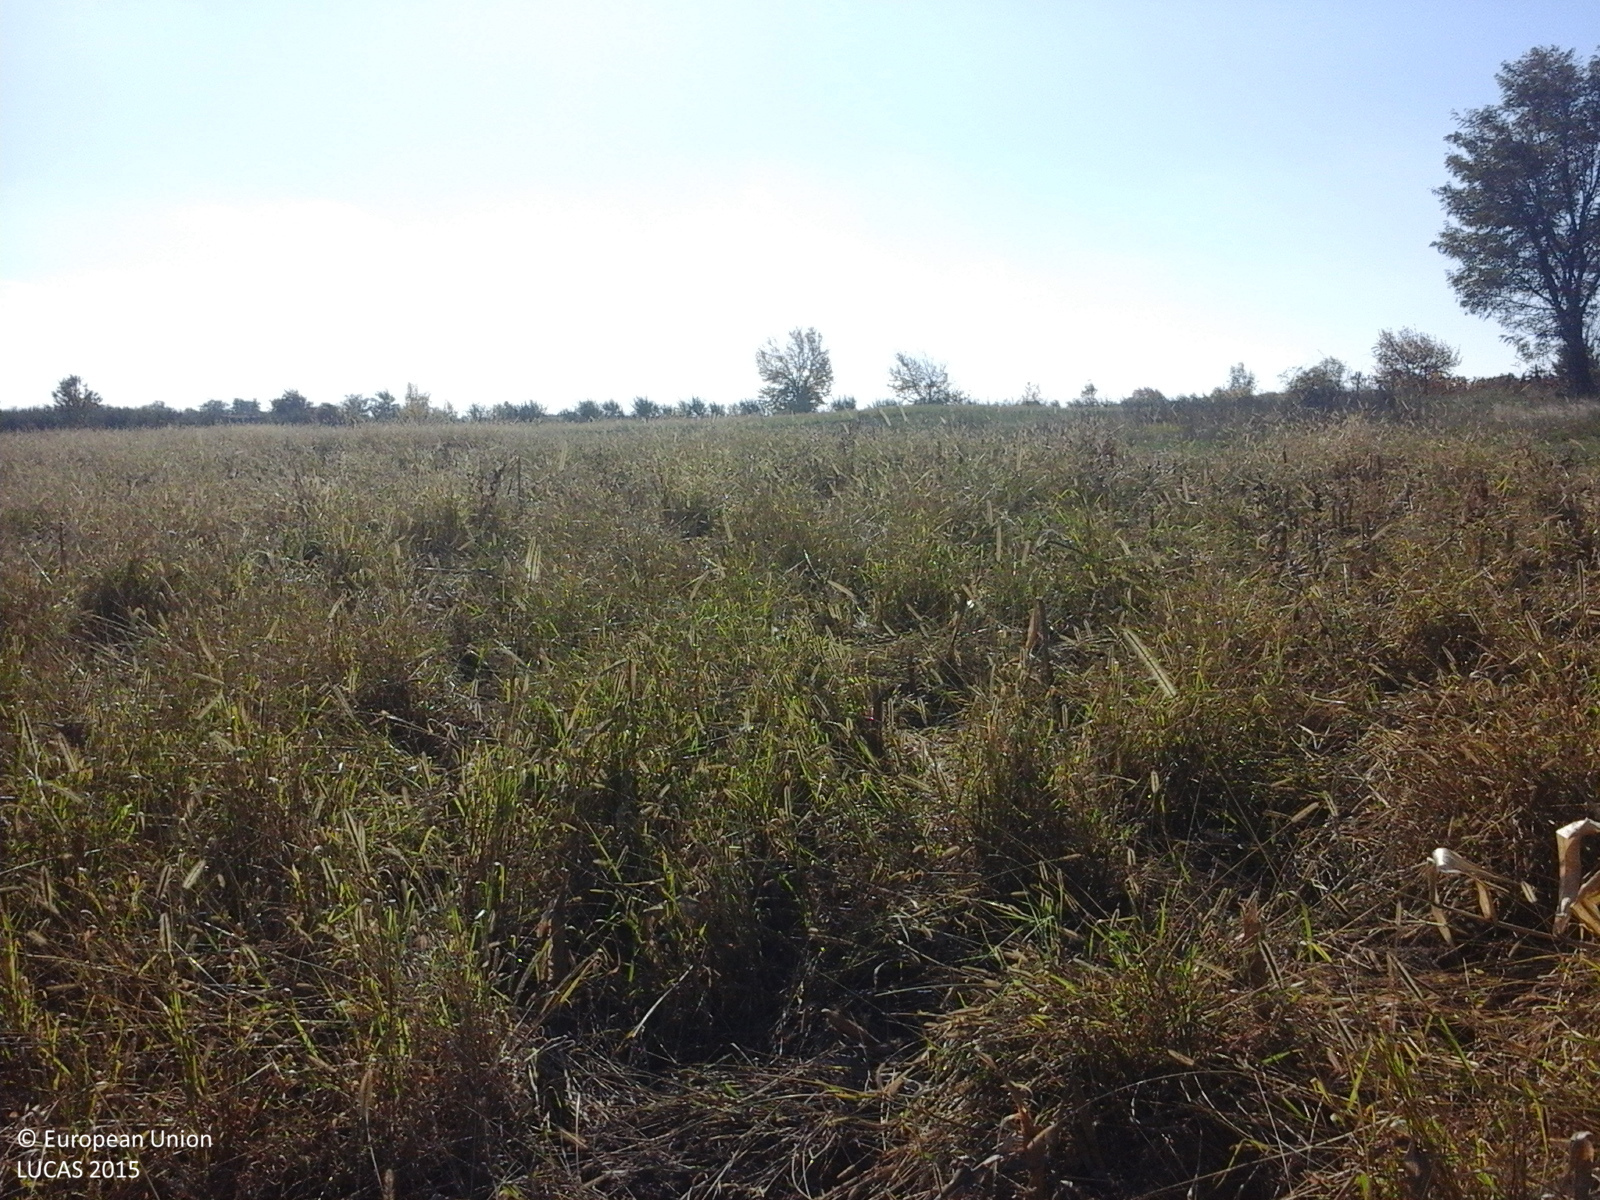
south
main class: Cropland
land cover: Maize
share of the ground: 25 - 50 %
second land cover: Spontaneously vegetated surfaces
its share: > 75 %
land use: Agriculture (excluding fallow land and kitchen gardens)
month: October
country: RO
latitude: 45.9956
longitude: 27.0726
